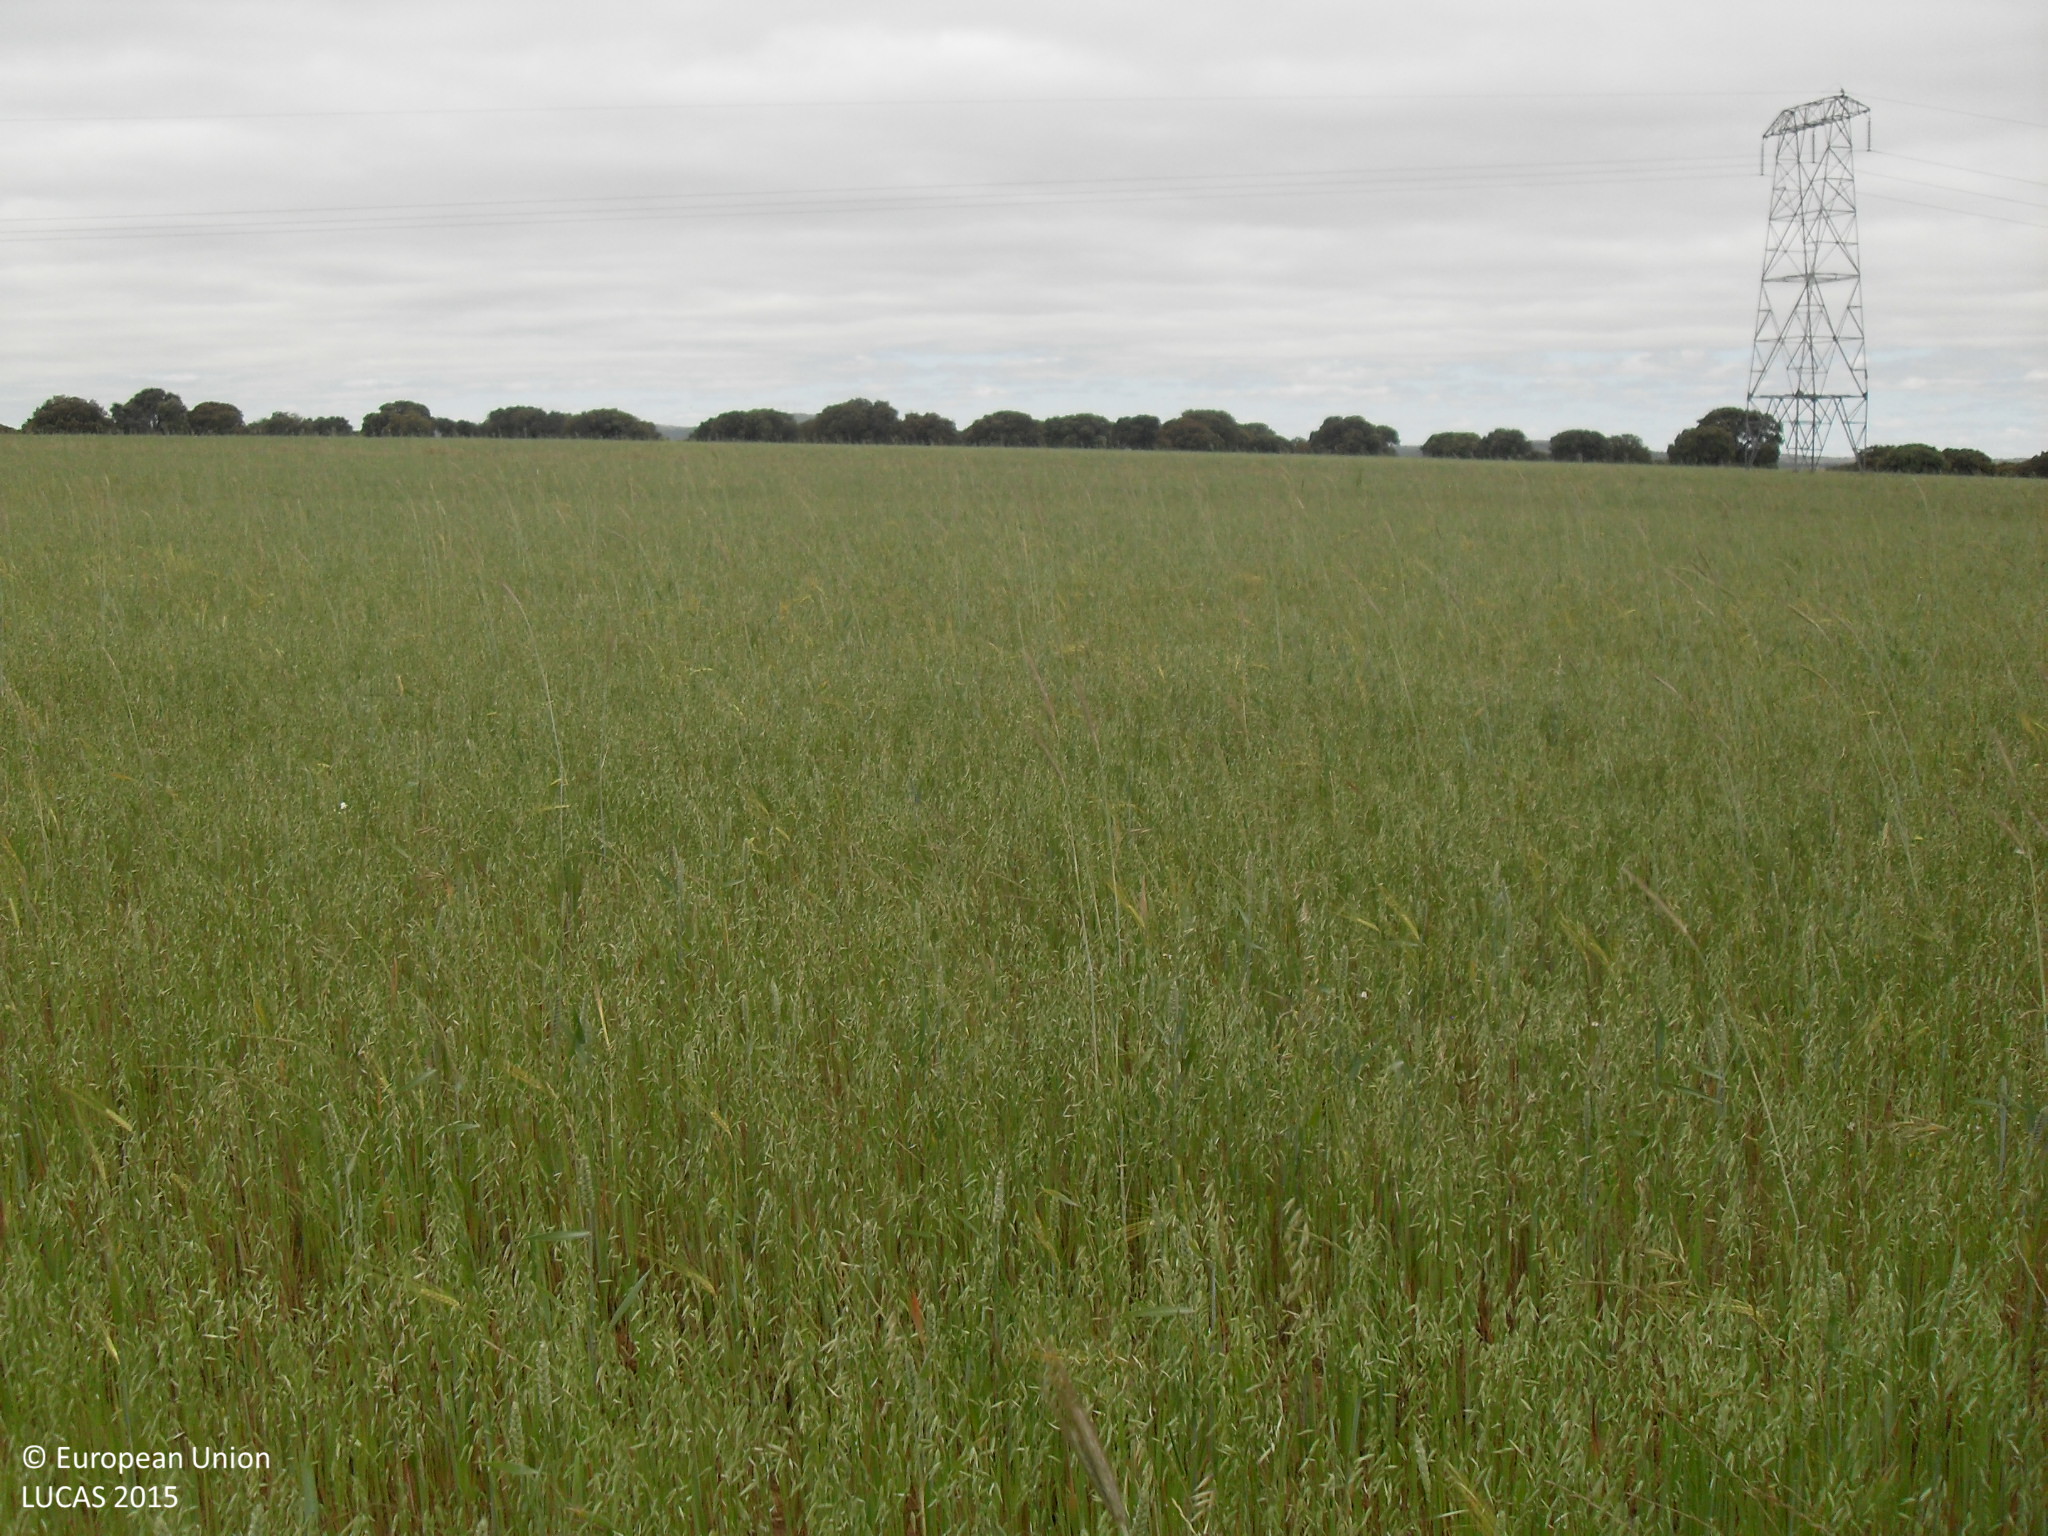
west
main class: Cropland
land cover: Oats
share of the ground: > 75 %
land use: Agriculture (excluding fallow land and kitchen gardens)
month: May
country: ES
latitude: 40.6610
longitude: -5.6260
